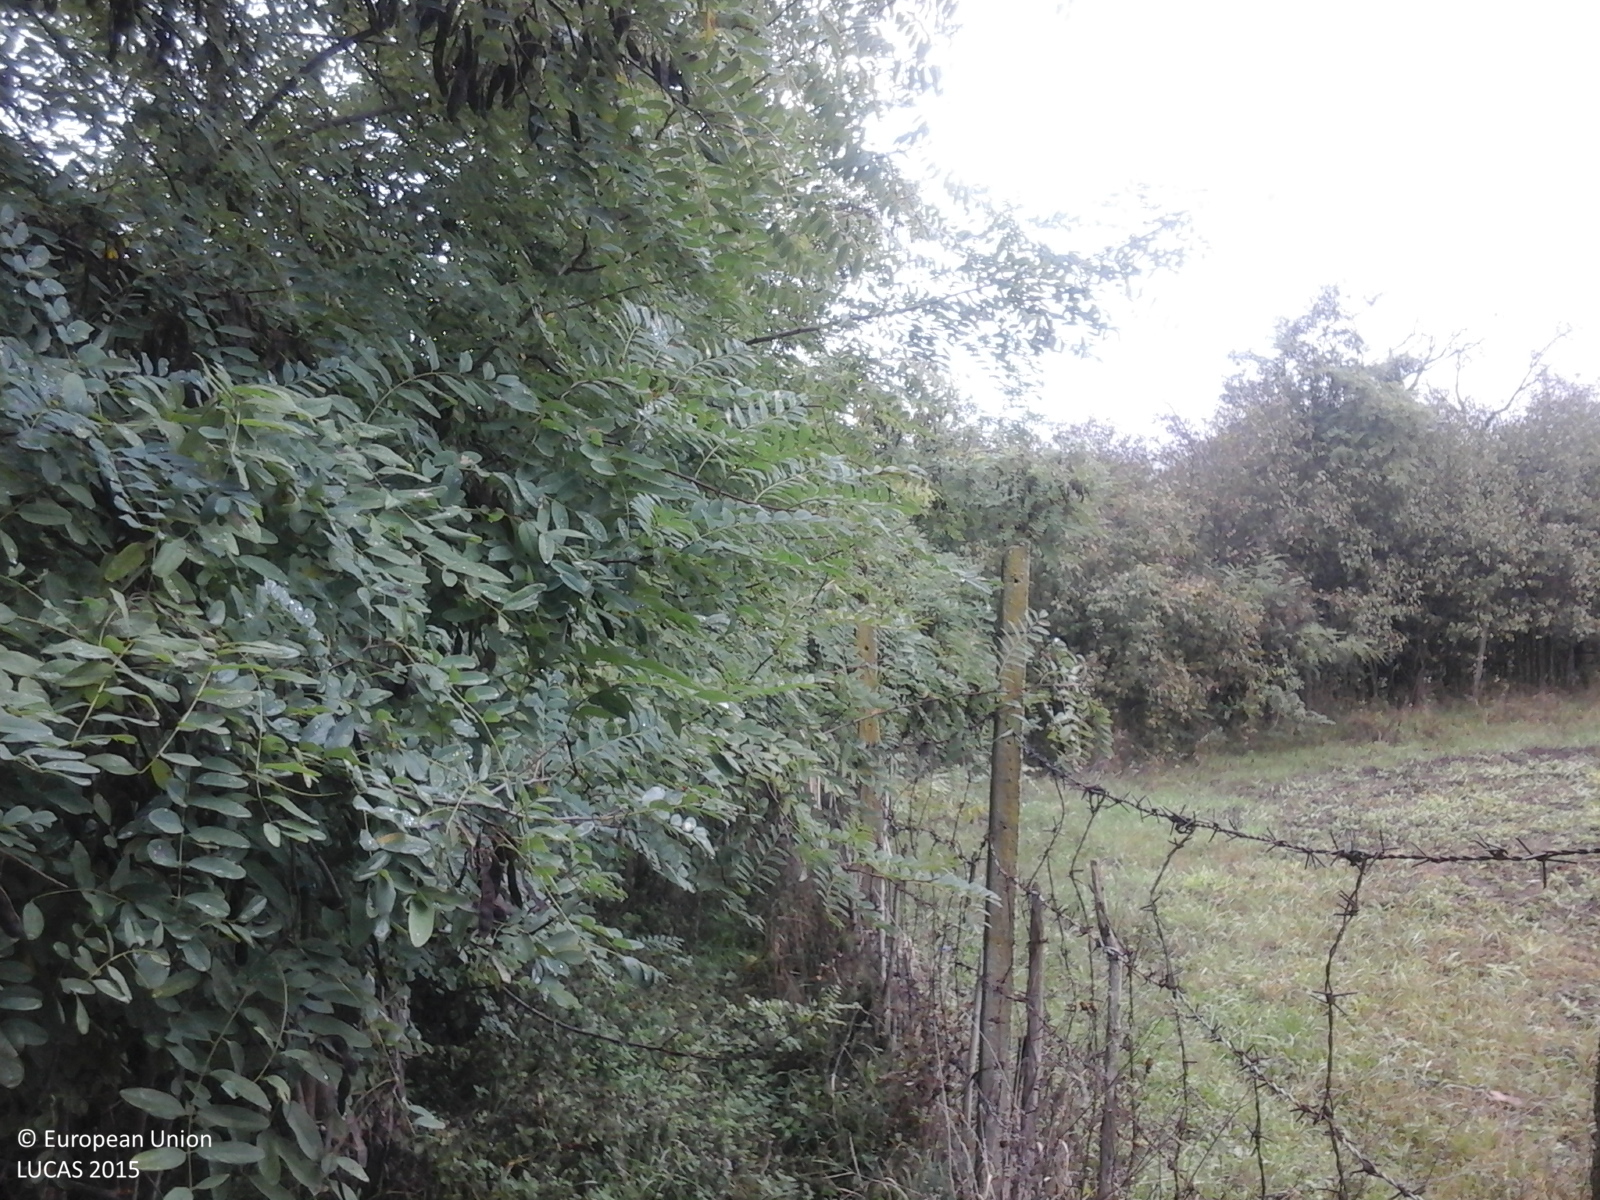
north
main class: Woodland
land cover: Broadleaved woodland
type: broadleaved evergreen forest
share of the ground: > 75 %
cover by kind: broadleaved forest trees 100 %
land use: Forestry
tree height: > 5 m
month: October
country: RO
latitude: 46.1850
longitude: 24.0550
